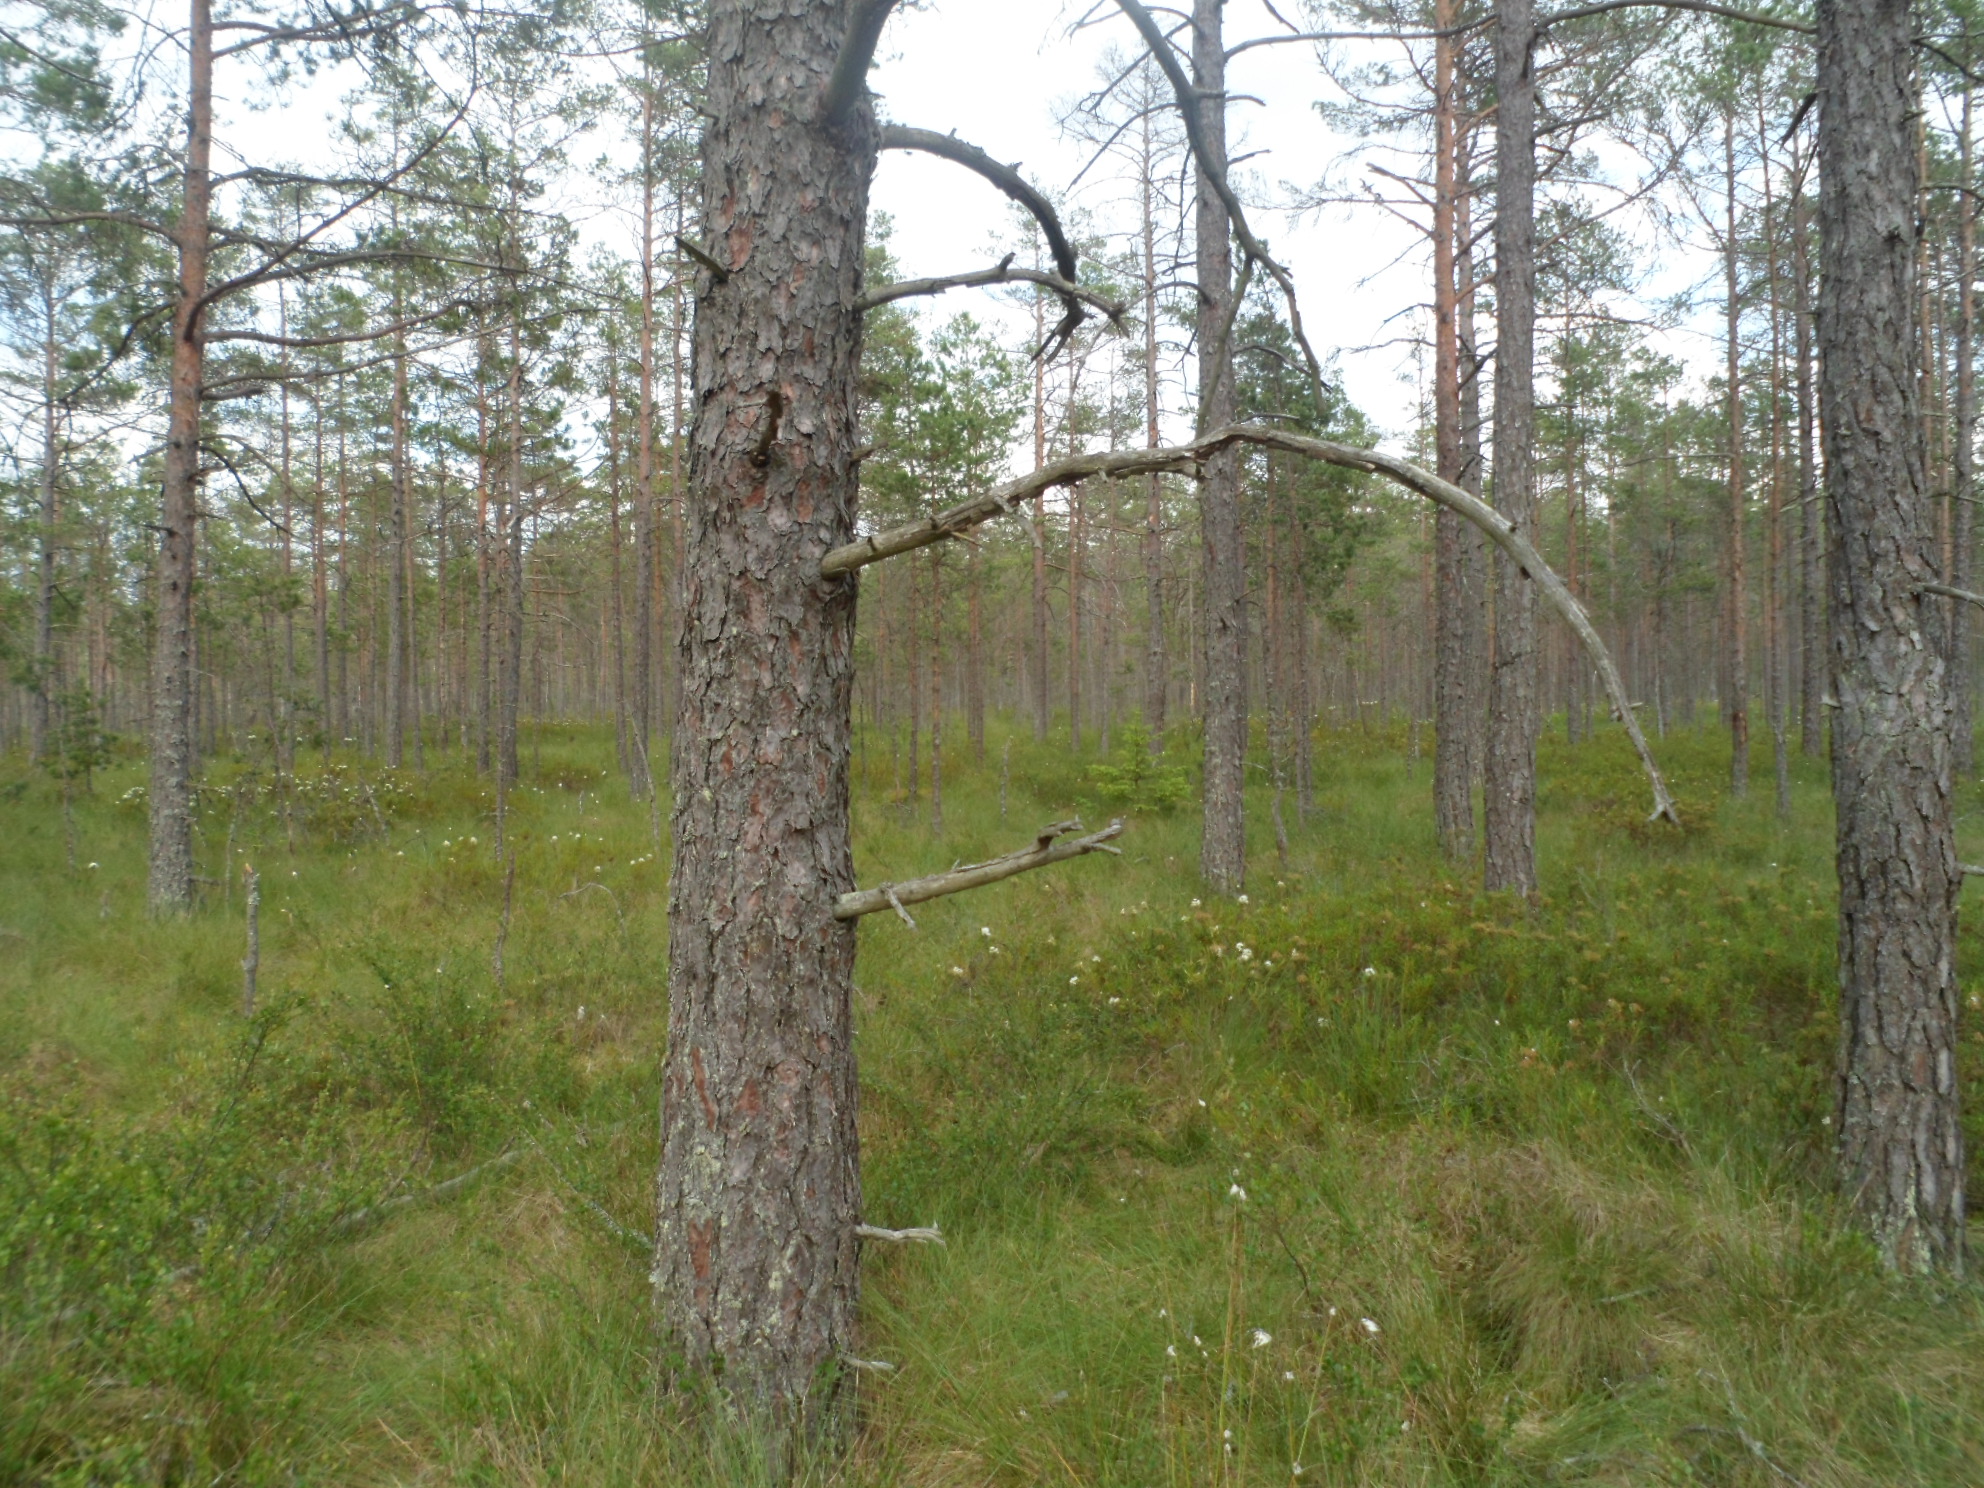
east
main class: Woodland
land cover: Pine dominated coniferous woodland
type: boreal forest
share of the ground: 25 - 50 %
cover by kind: coniferous forest trees 50 %, lichens and mosses 25 %, shrubs 20 %, herbaceous plants 5 %
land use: Forestry
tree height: > 5 m
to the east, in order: Pine dominated coniferous woodland; Rock outcrops; Pine dominated mixed woodland
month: June
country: SE
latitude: 57.1334
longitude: 15.4994
